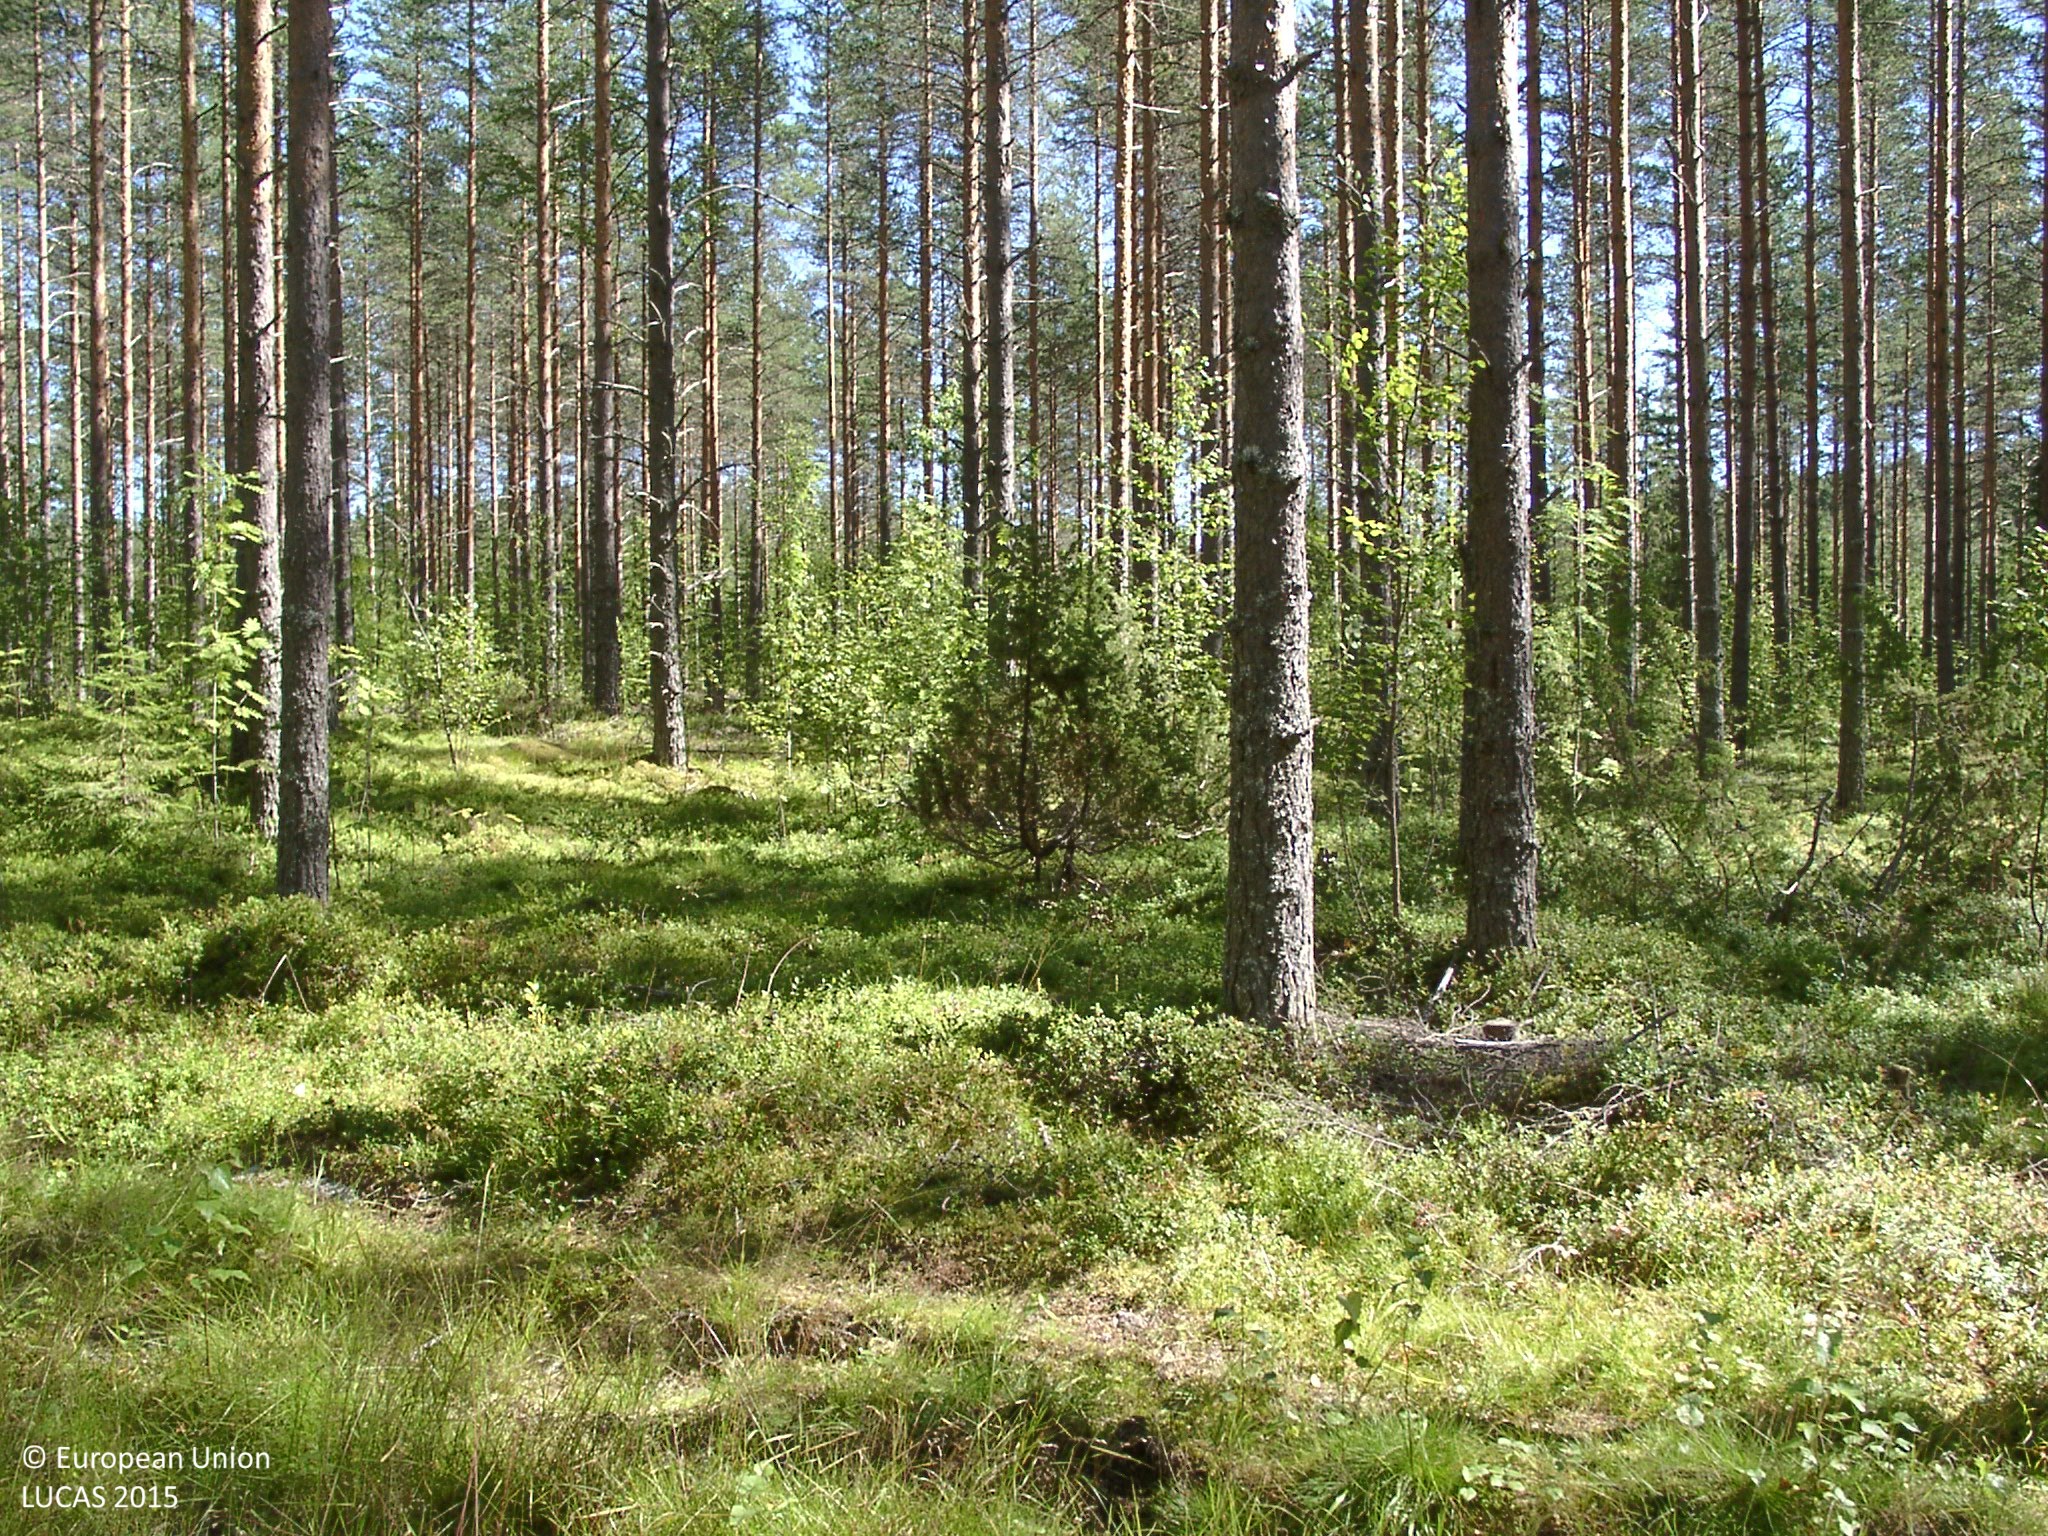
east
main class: Woodland
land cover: Pine dominated coniferous woodland
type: boreal forest
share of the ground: 50 - 75 %
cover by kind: coniferous forest trees 55 %, shrubs 20 %, broadleaved forest trees 15 %, lichens and mosses 10 %
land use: Forestry
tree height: > 5 m
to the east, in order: Tracks; Pine dominated coniferous woodland; Shruby margins; Pine dominated coniferous woodland; Shruby margins; Pine dominated coniferous woodland; Tracks; Spruce dominated coniferous woodland; Artificial constructions; Ditches and canals; Spruce dominated coniferous woodland; Other coniferous woodland; Tracks; Pine dominated mixed woodland
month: August
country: FI
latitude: 62.3606
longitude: 25.2760
